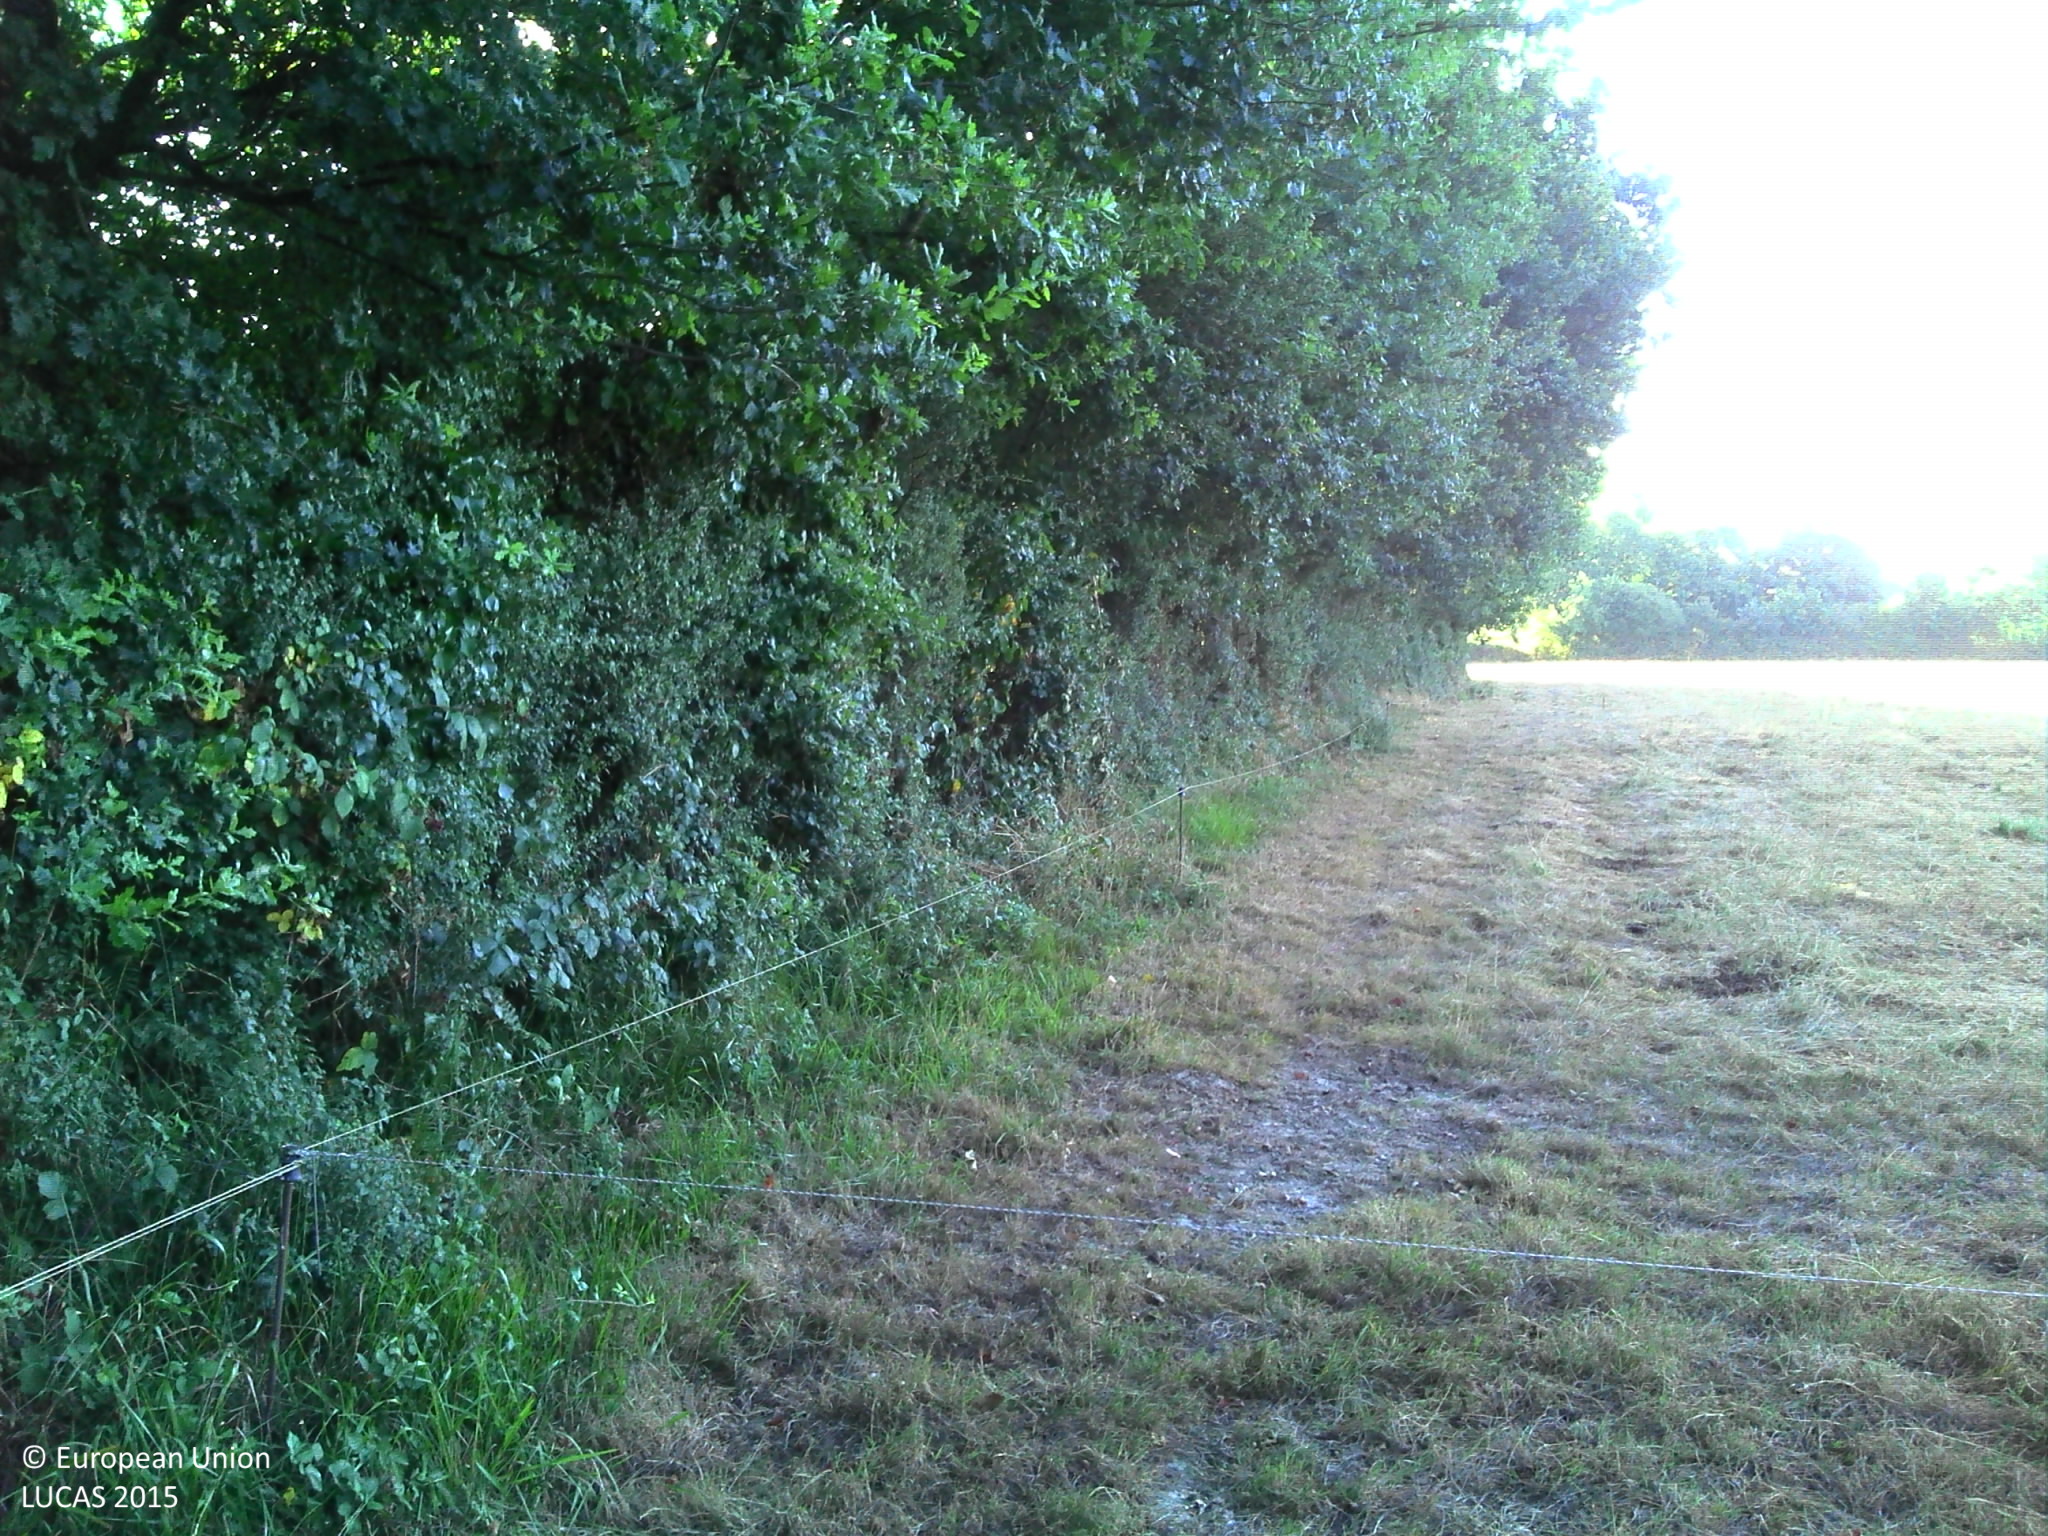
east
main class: Grassland
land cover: Grassland without tree/shrub cover
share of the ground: > 75 %
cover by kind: herbaceous plants 100 %
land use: Agriculture (excluding fallow land and kitchen gardens)
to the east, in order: Grassland without tree/shrub cover; Fences; Broadleaved woodland; Ditches and canals; Grass margins; Tracks; Grass margins; Ditches and canals; Broadleaved woodland; Fences; Temporary grasslands; Fences; Managed hedges; Ditches and canals; Grass margins; Paved roads, cycling and walking lanes; Grass margins; Ditches and canals; Broadleaved woodland; Fences; Grassland without tree/shrub cover
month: August
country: FR
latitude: 47.4309
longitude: -1.5644
